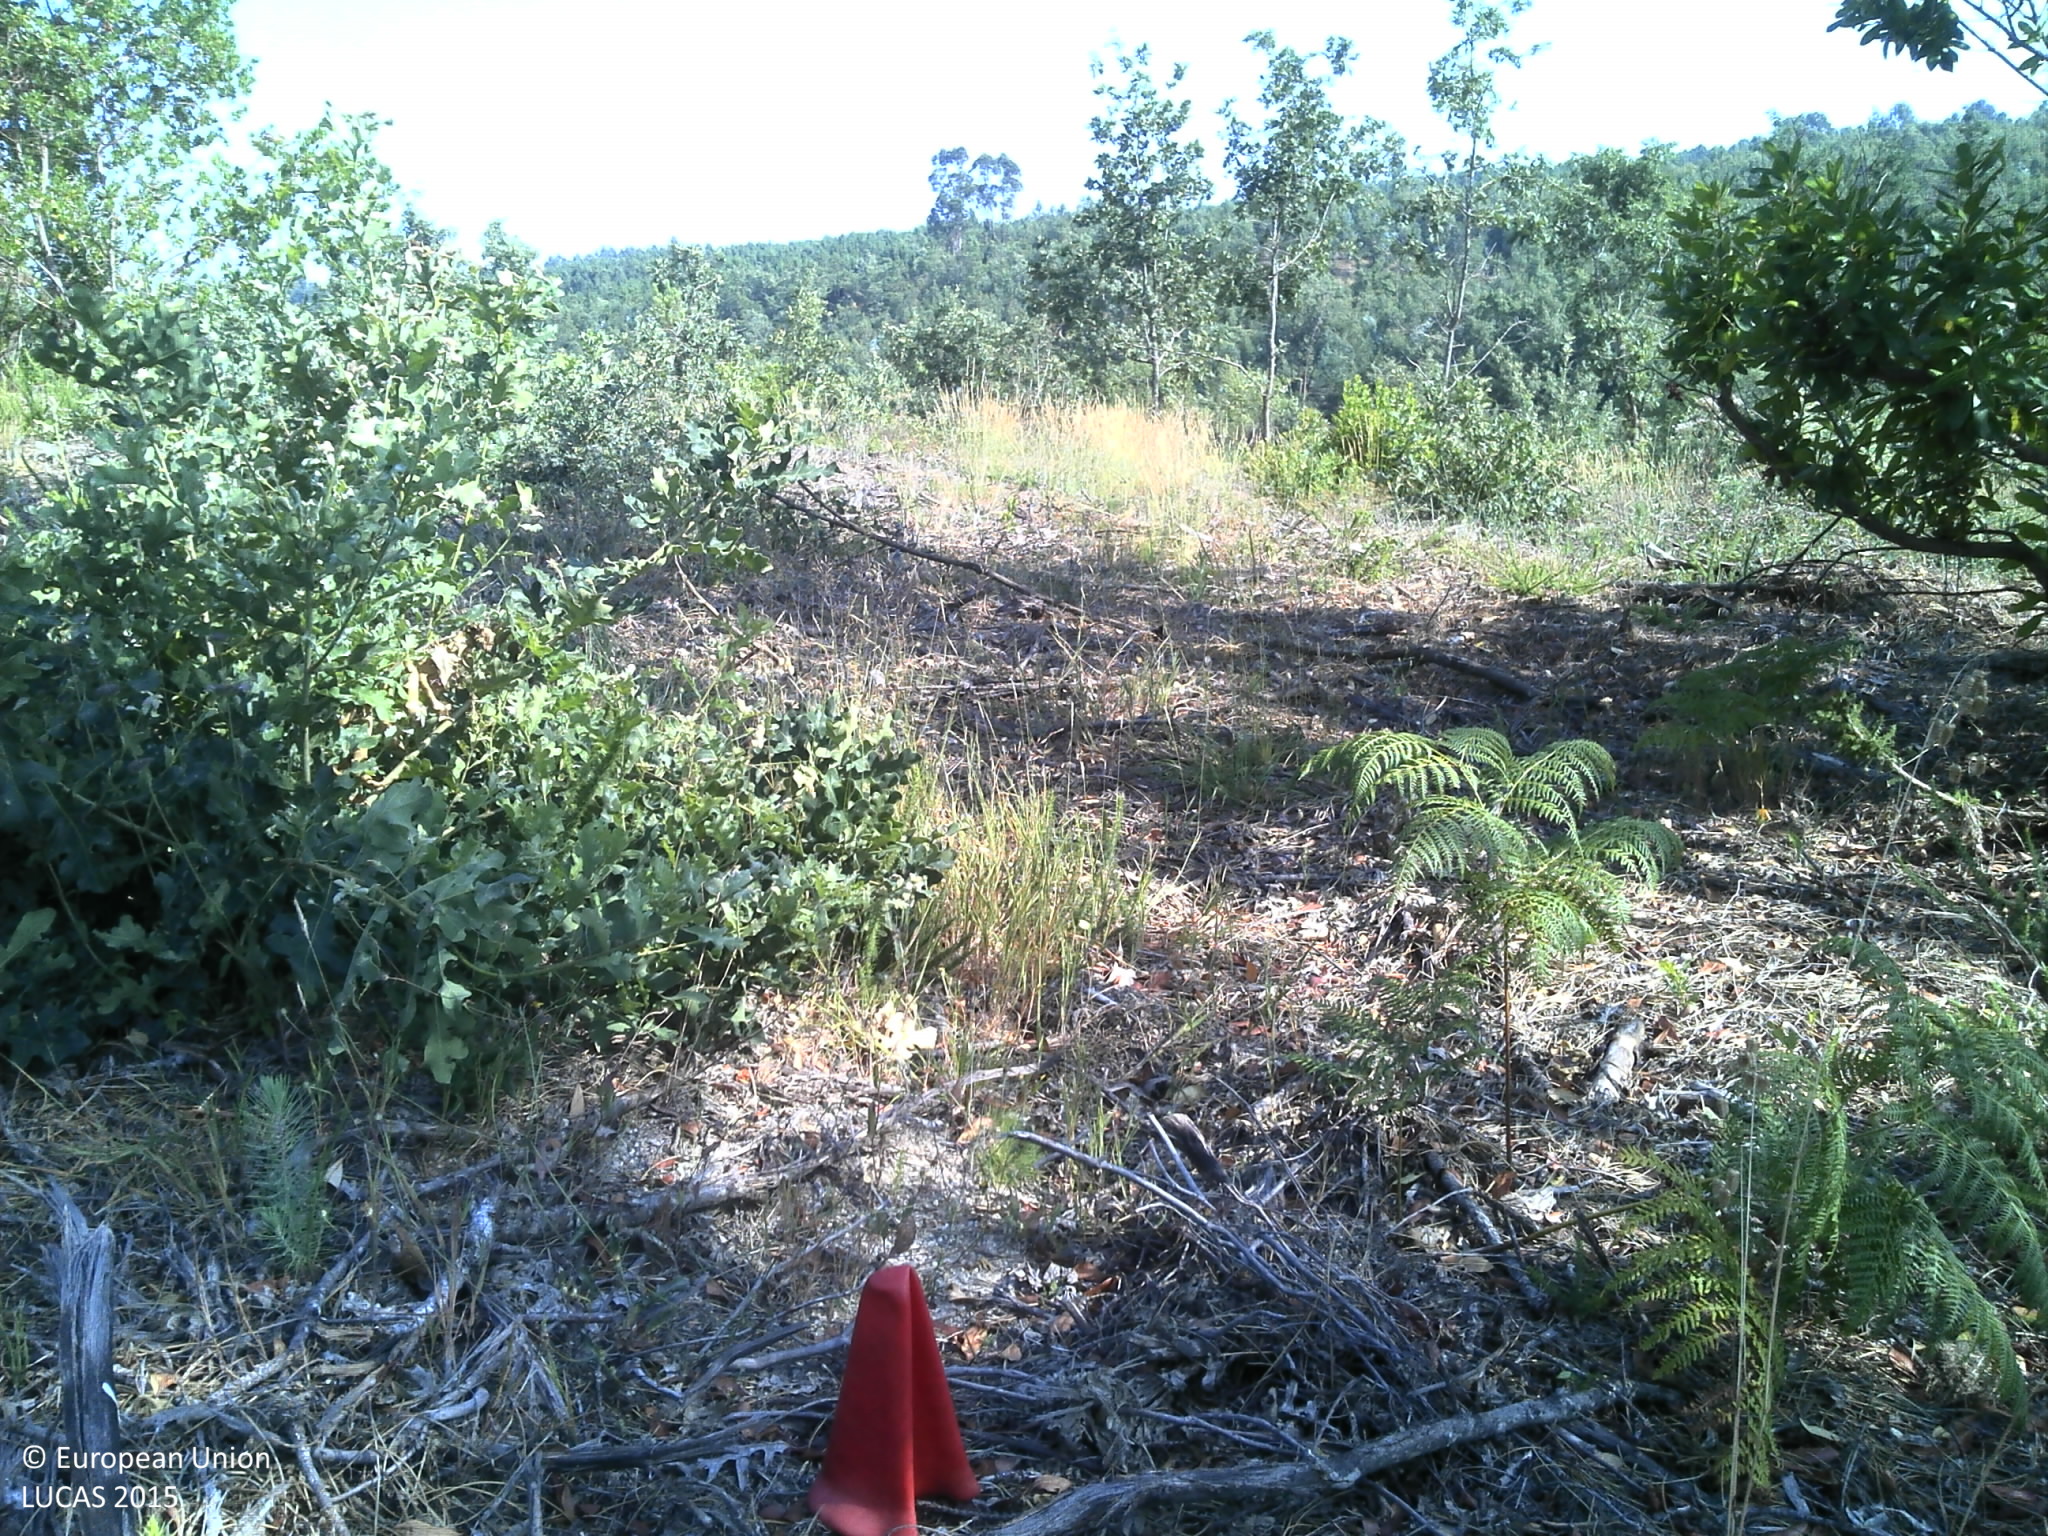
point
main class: Shrubland
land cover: Shrubland with sparse tree cover
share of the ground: 50 - 75 %
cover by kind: shrubs 60 %, herbaceous plants 30 %, broadleaved forest trees 5 %, unconsolidated bare surface 5 %
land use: Forestry
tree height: > 5 m
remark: Clear cut
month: June
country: PT
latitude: 40.4151
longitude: -7.8066
